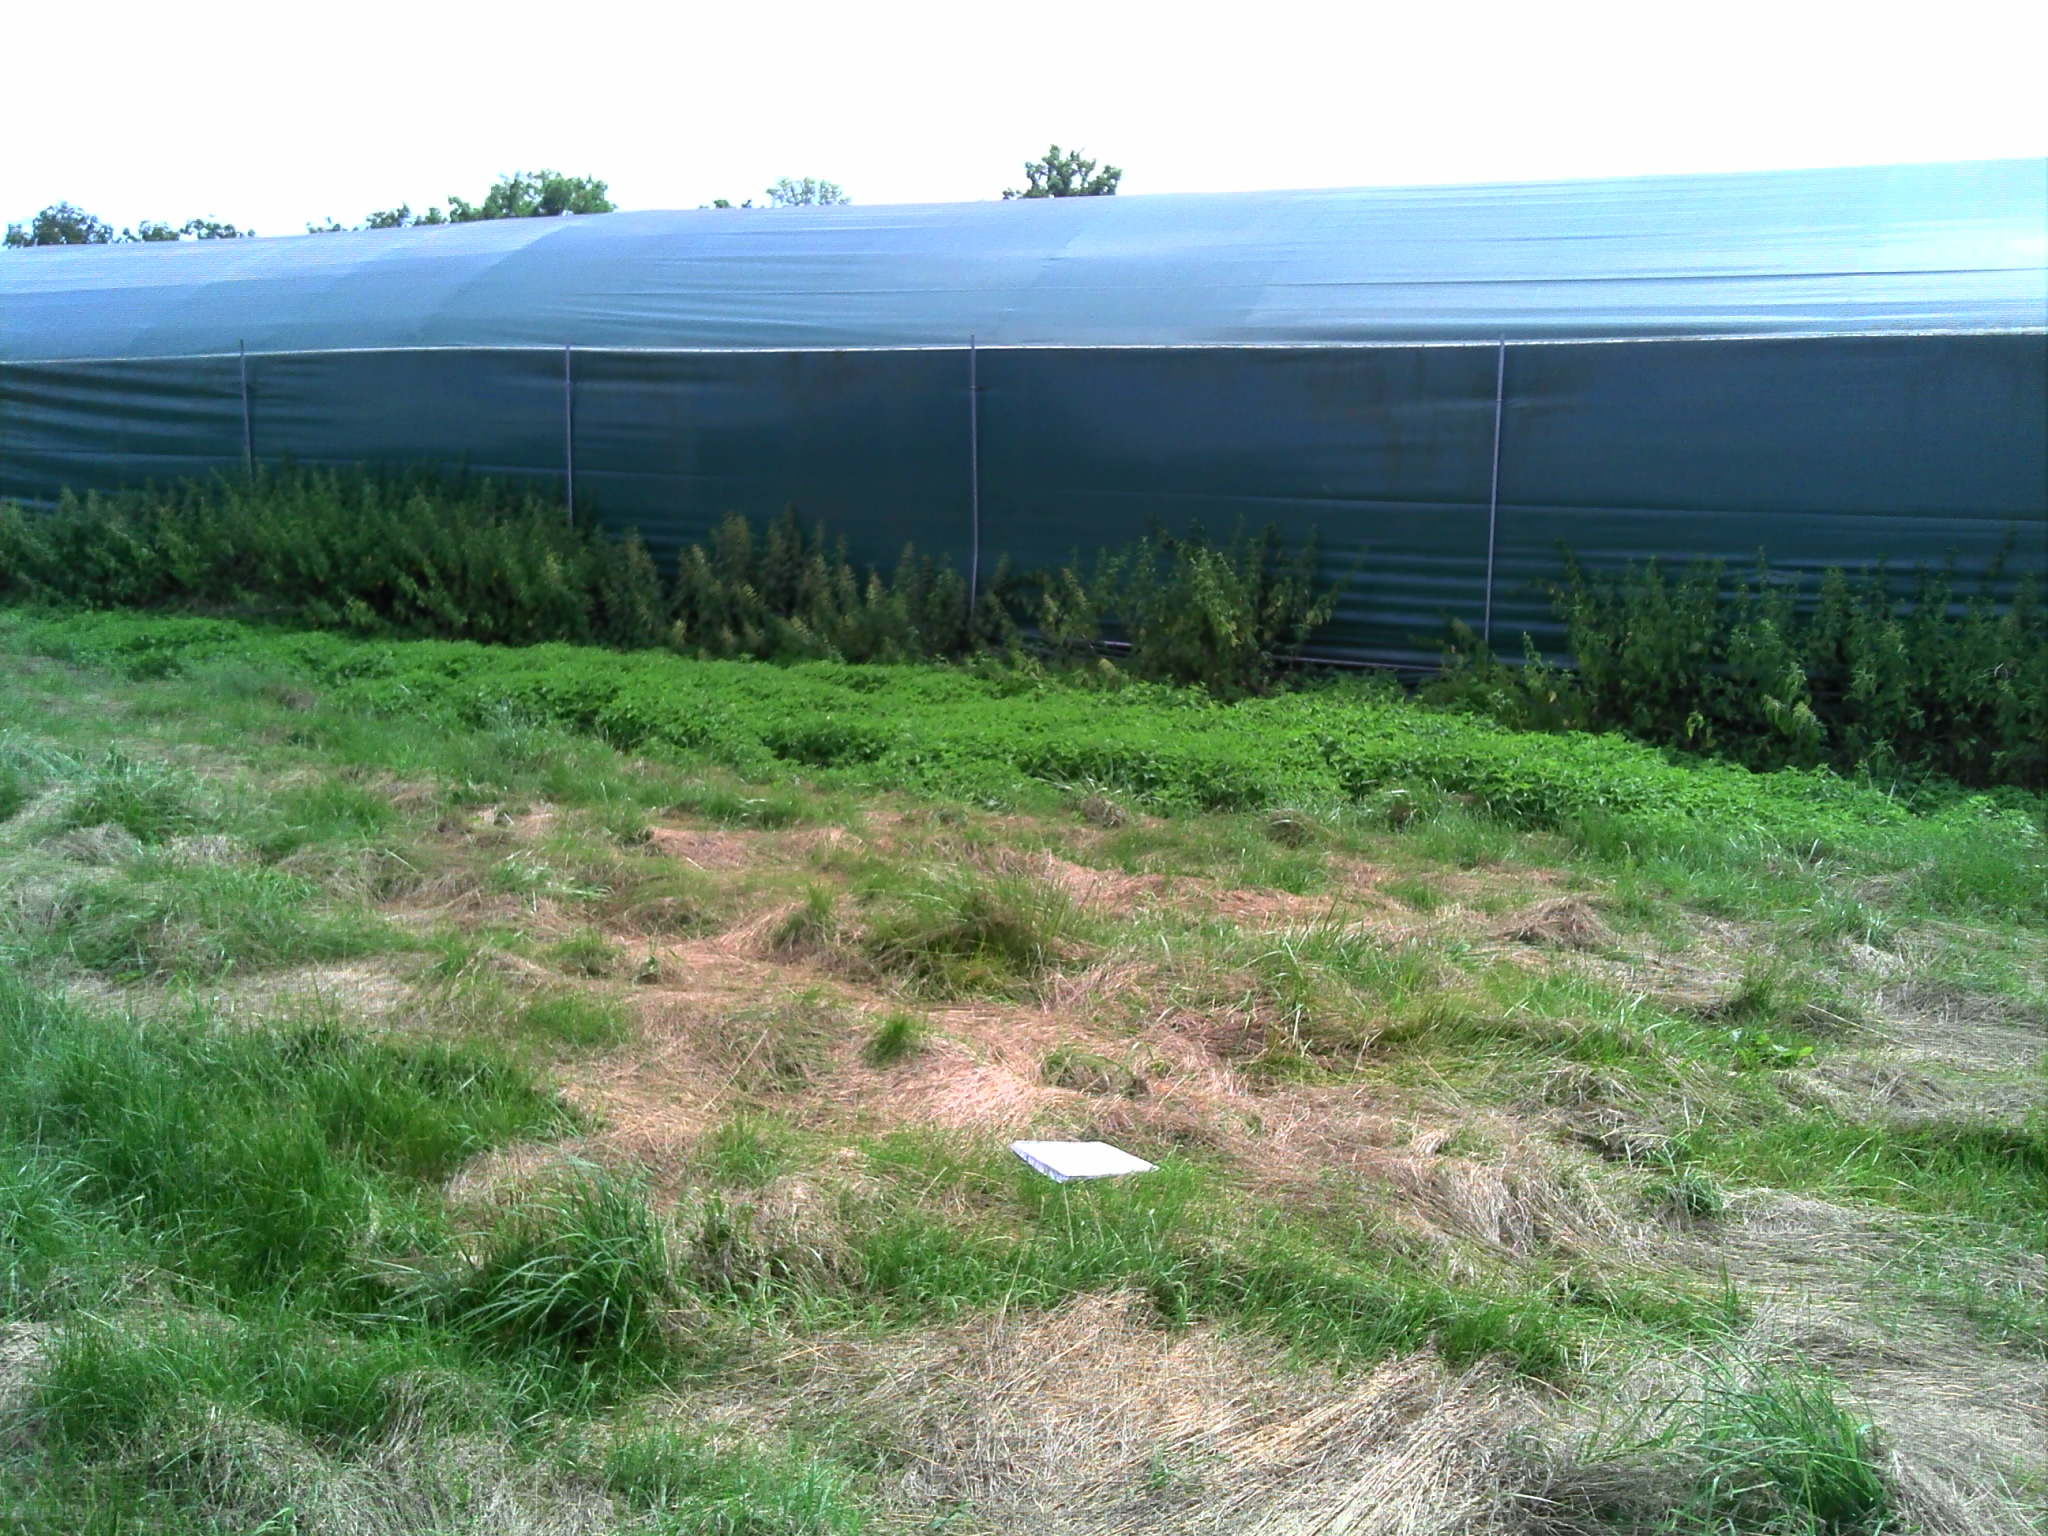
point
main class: Grassland
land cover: Grassland without tree/shrub cover
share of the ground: > 75 %
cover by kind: herbaceous plants 100 %
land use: Agriculture (excluding fallow land and kitchen gardens)
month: June
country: FR
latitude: 44.9155
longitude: 1.8275
